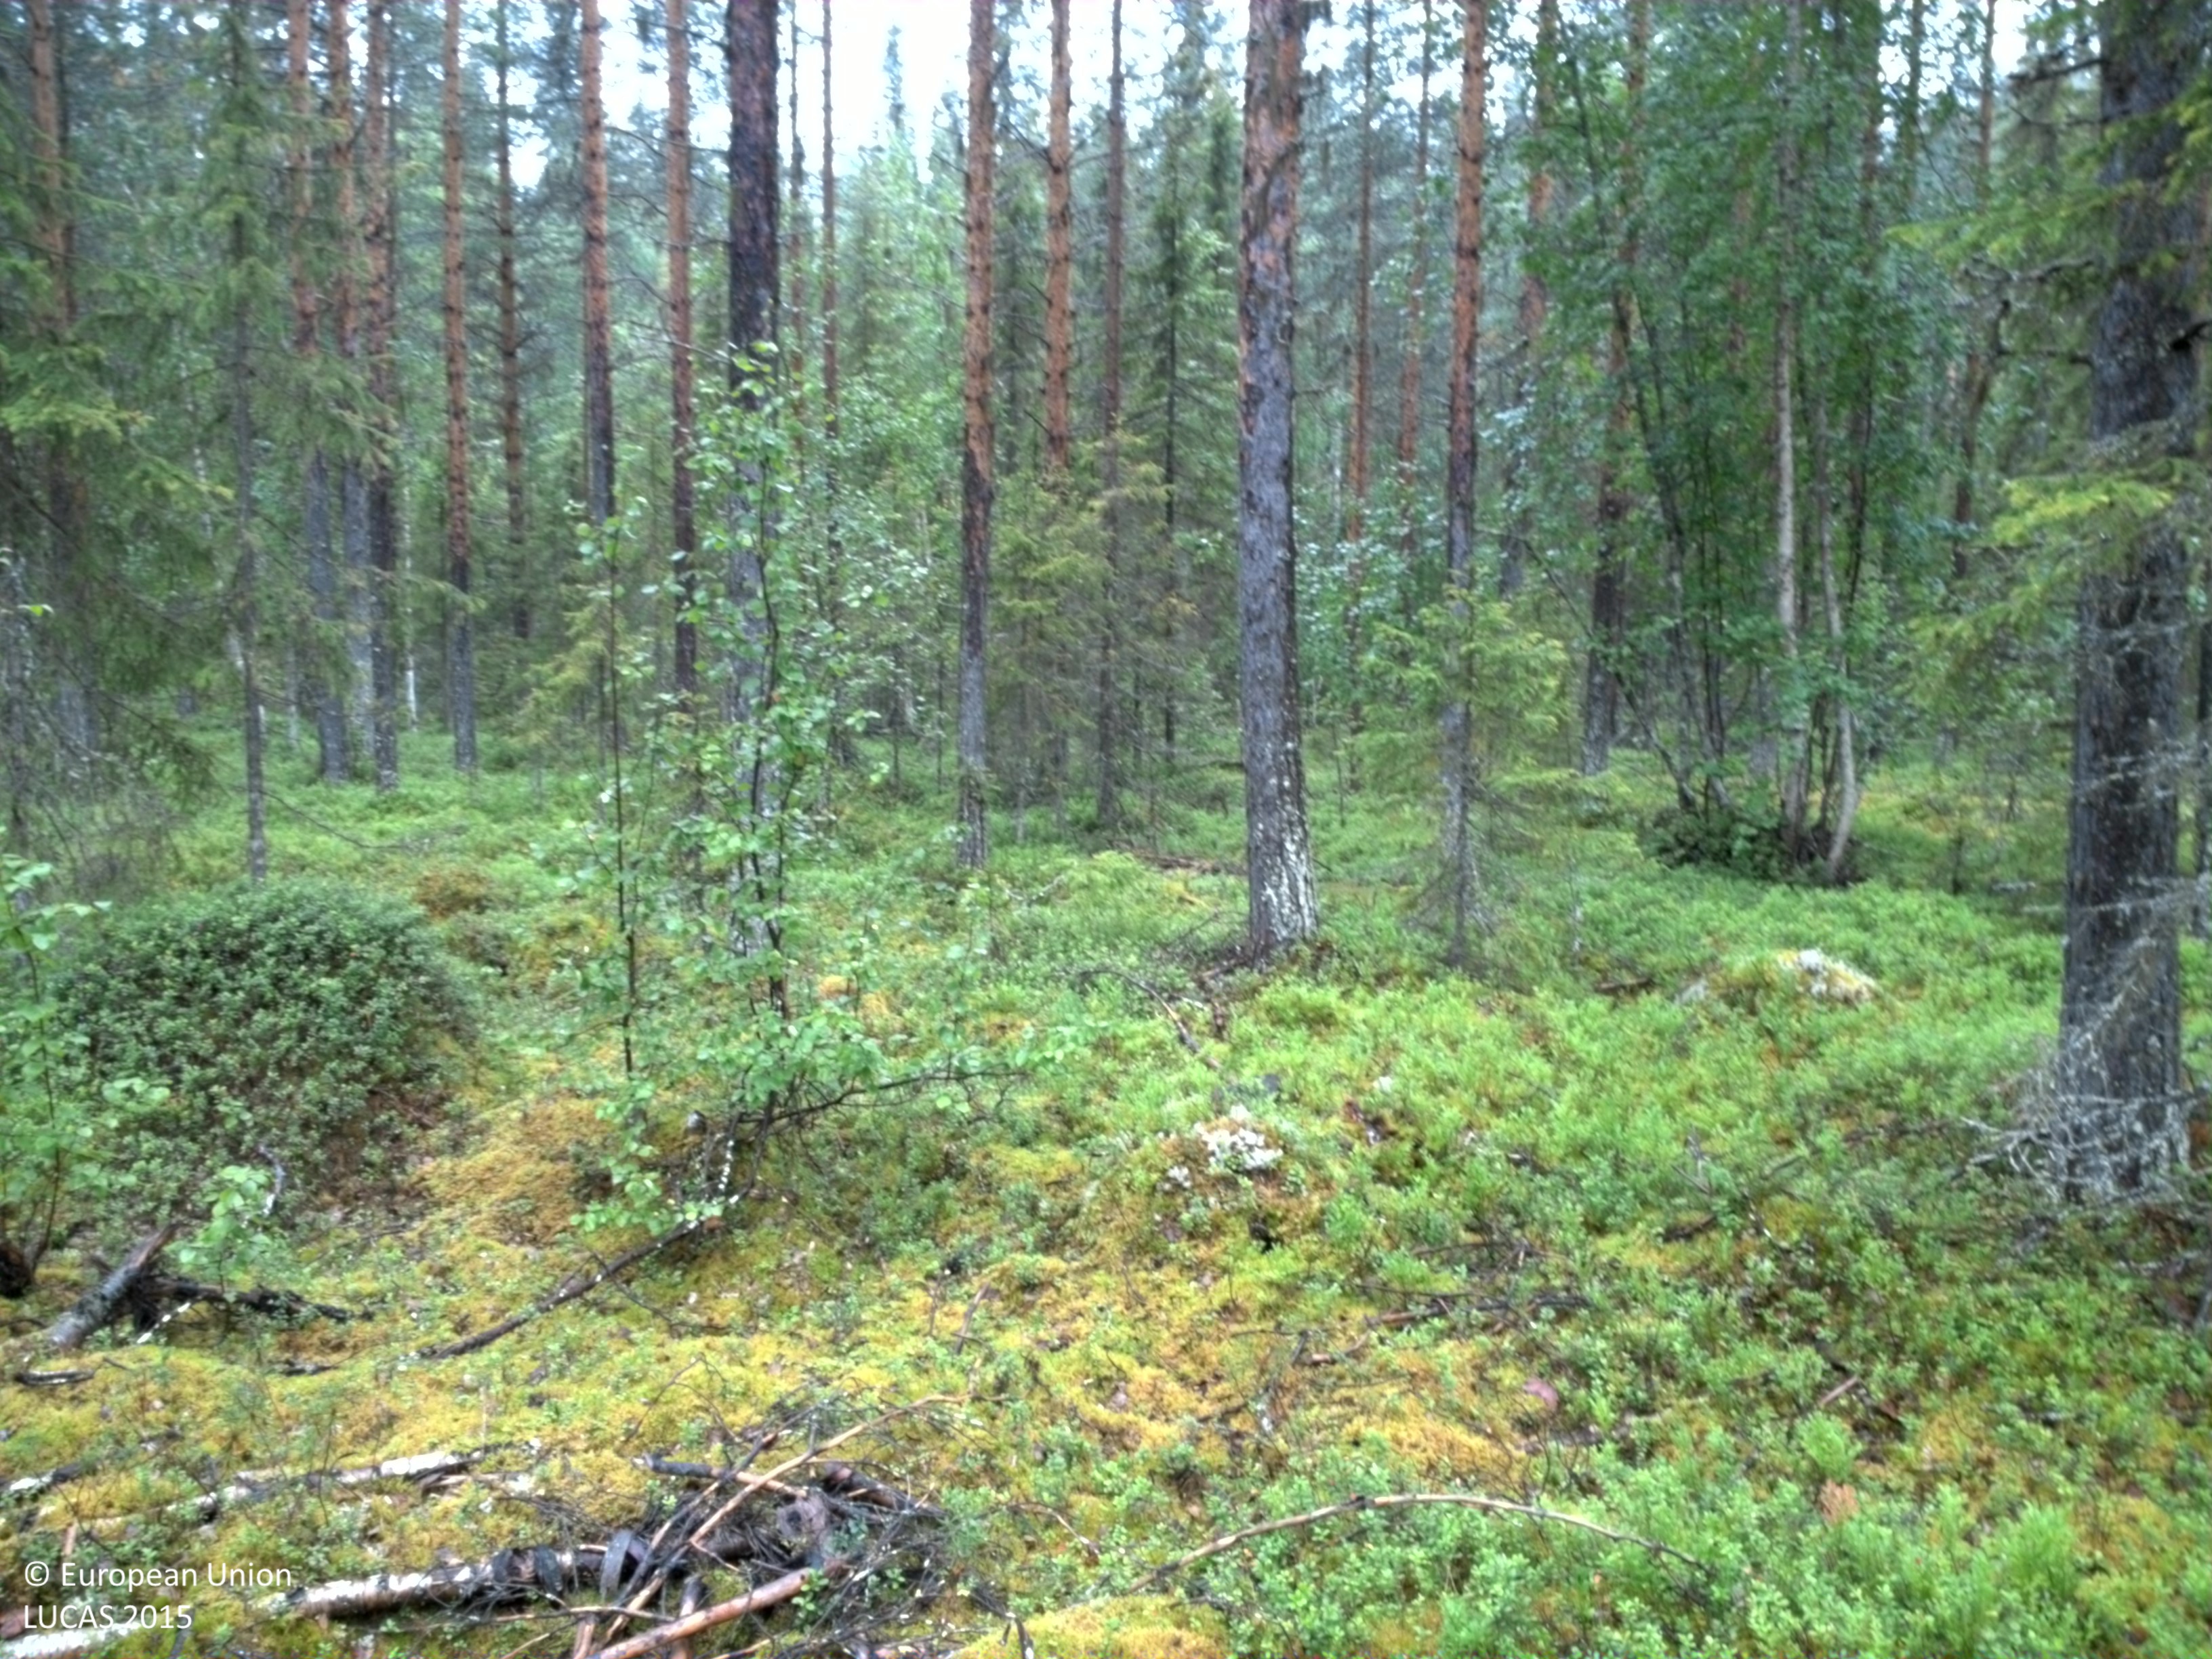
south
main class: Woodland
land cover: Pine dominated coniferous woodland
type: boreal forest
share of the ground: 25 - 50 %
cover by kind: shrubs 55 %, coniferous forest trees 35 %, broadleaved forest trees 5 %, lichens and mosses 5 %
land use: Forestry
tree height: > 5 m
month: August
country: SE
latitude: 66.4386
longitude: 20.5613
